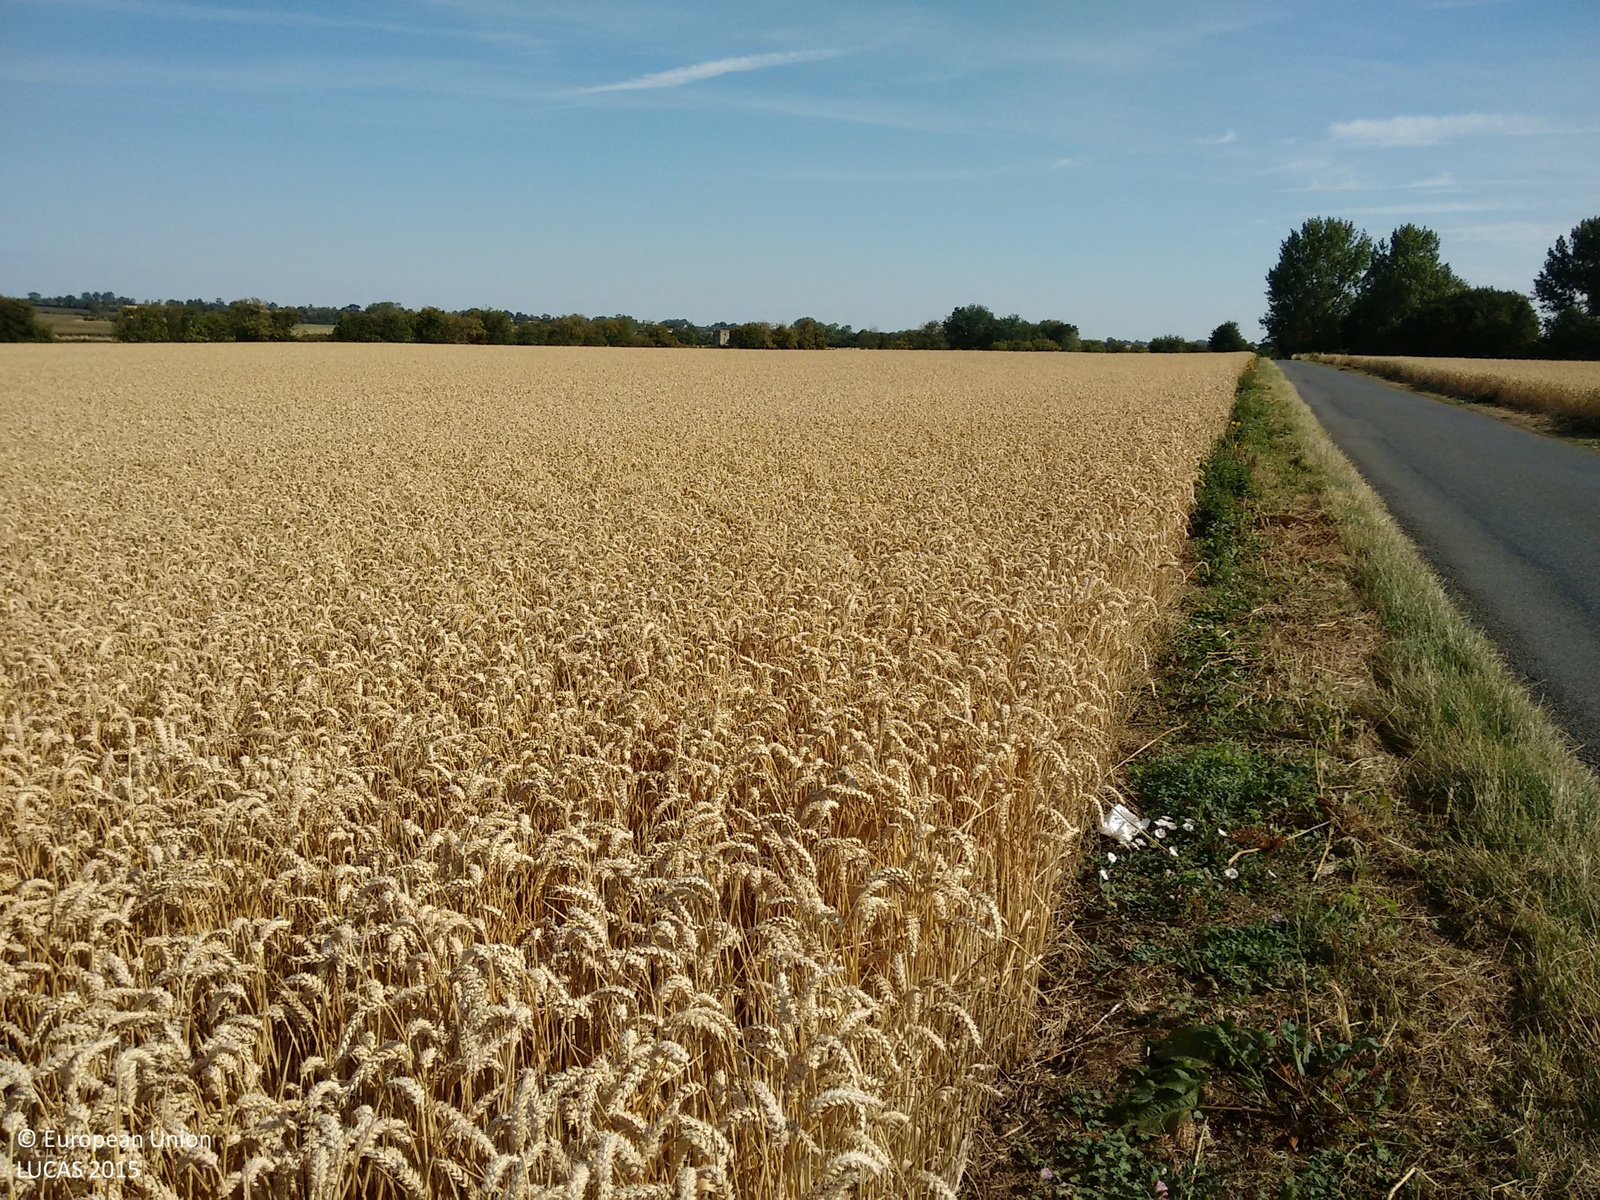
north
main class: Cropland
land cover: Common wheat
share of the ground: > 75 %
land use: Agriculture (excluding fallow land and kitchen gardens)
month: August
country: GB
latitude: 52.1869
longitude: -0.8518
